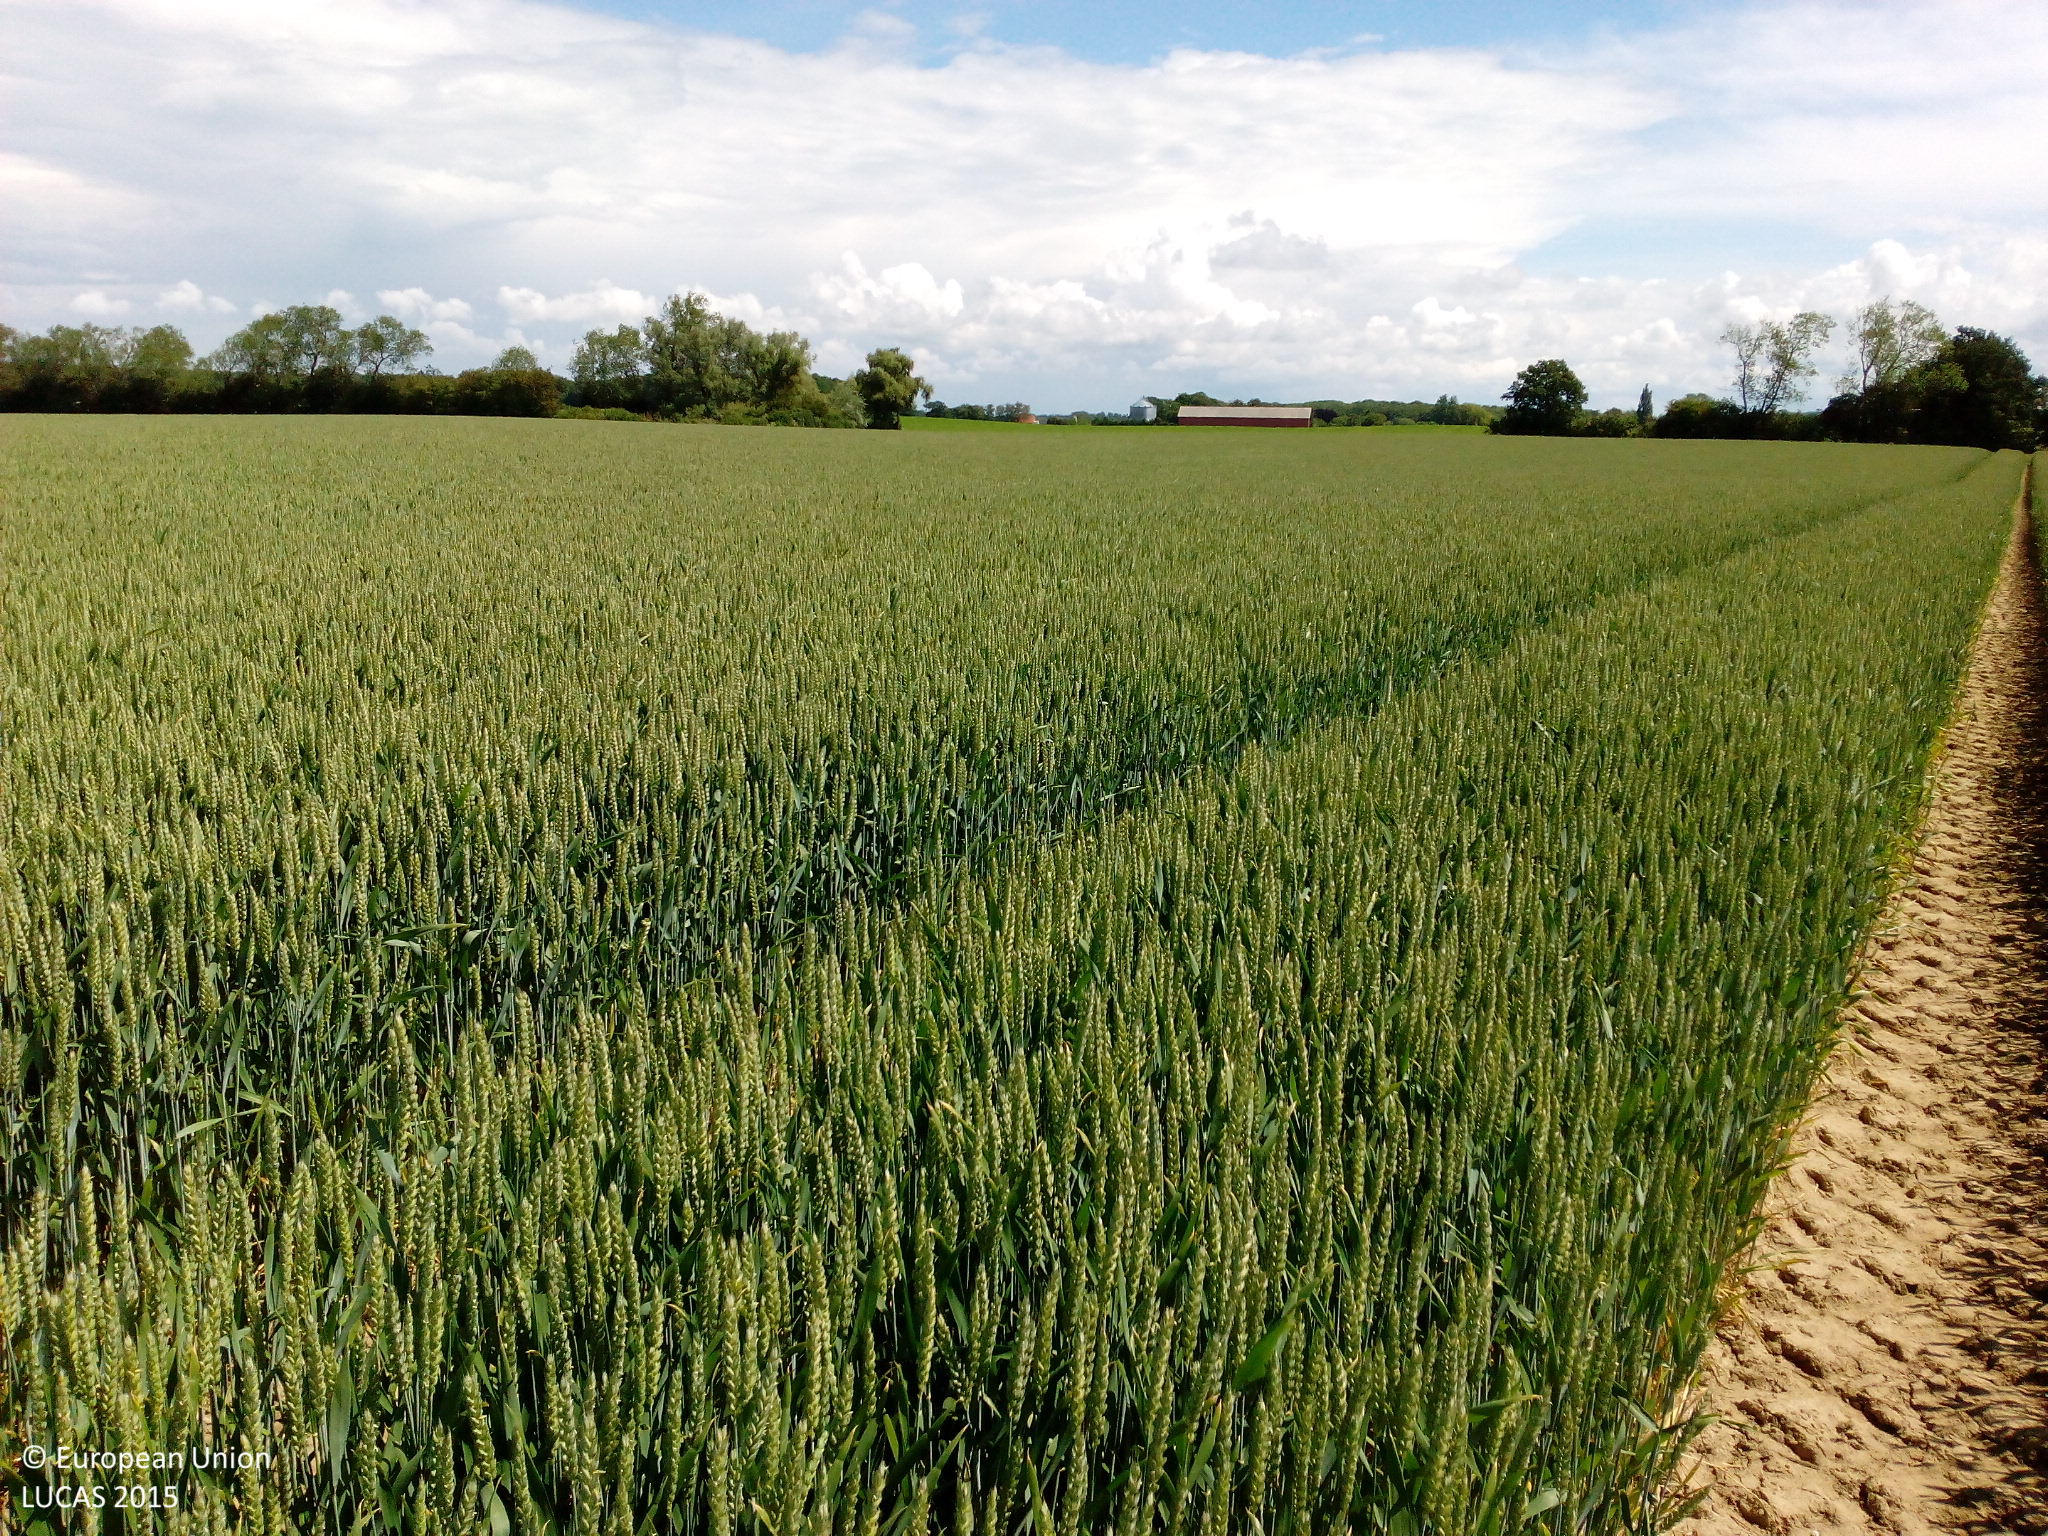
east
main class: Cropland
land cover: Common wheat
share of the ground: > 75 %
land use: Agriculture (excluding fallow land and kitchen gardens)
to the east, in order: Common wheat; Sugar beet
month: June
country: DK
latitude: 54.8122
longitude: 11.5394
